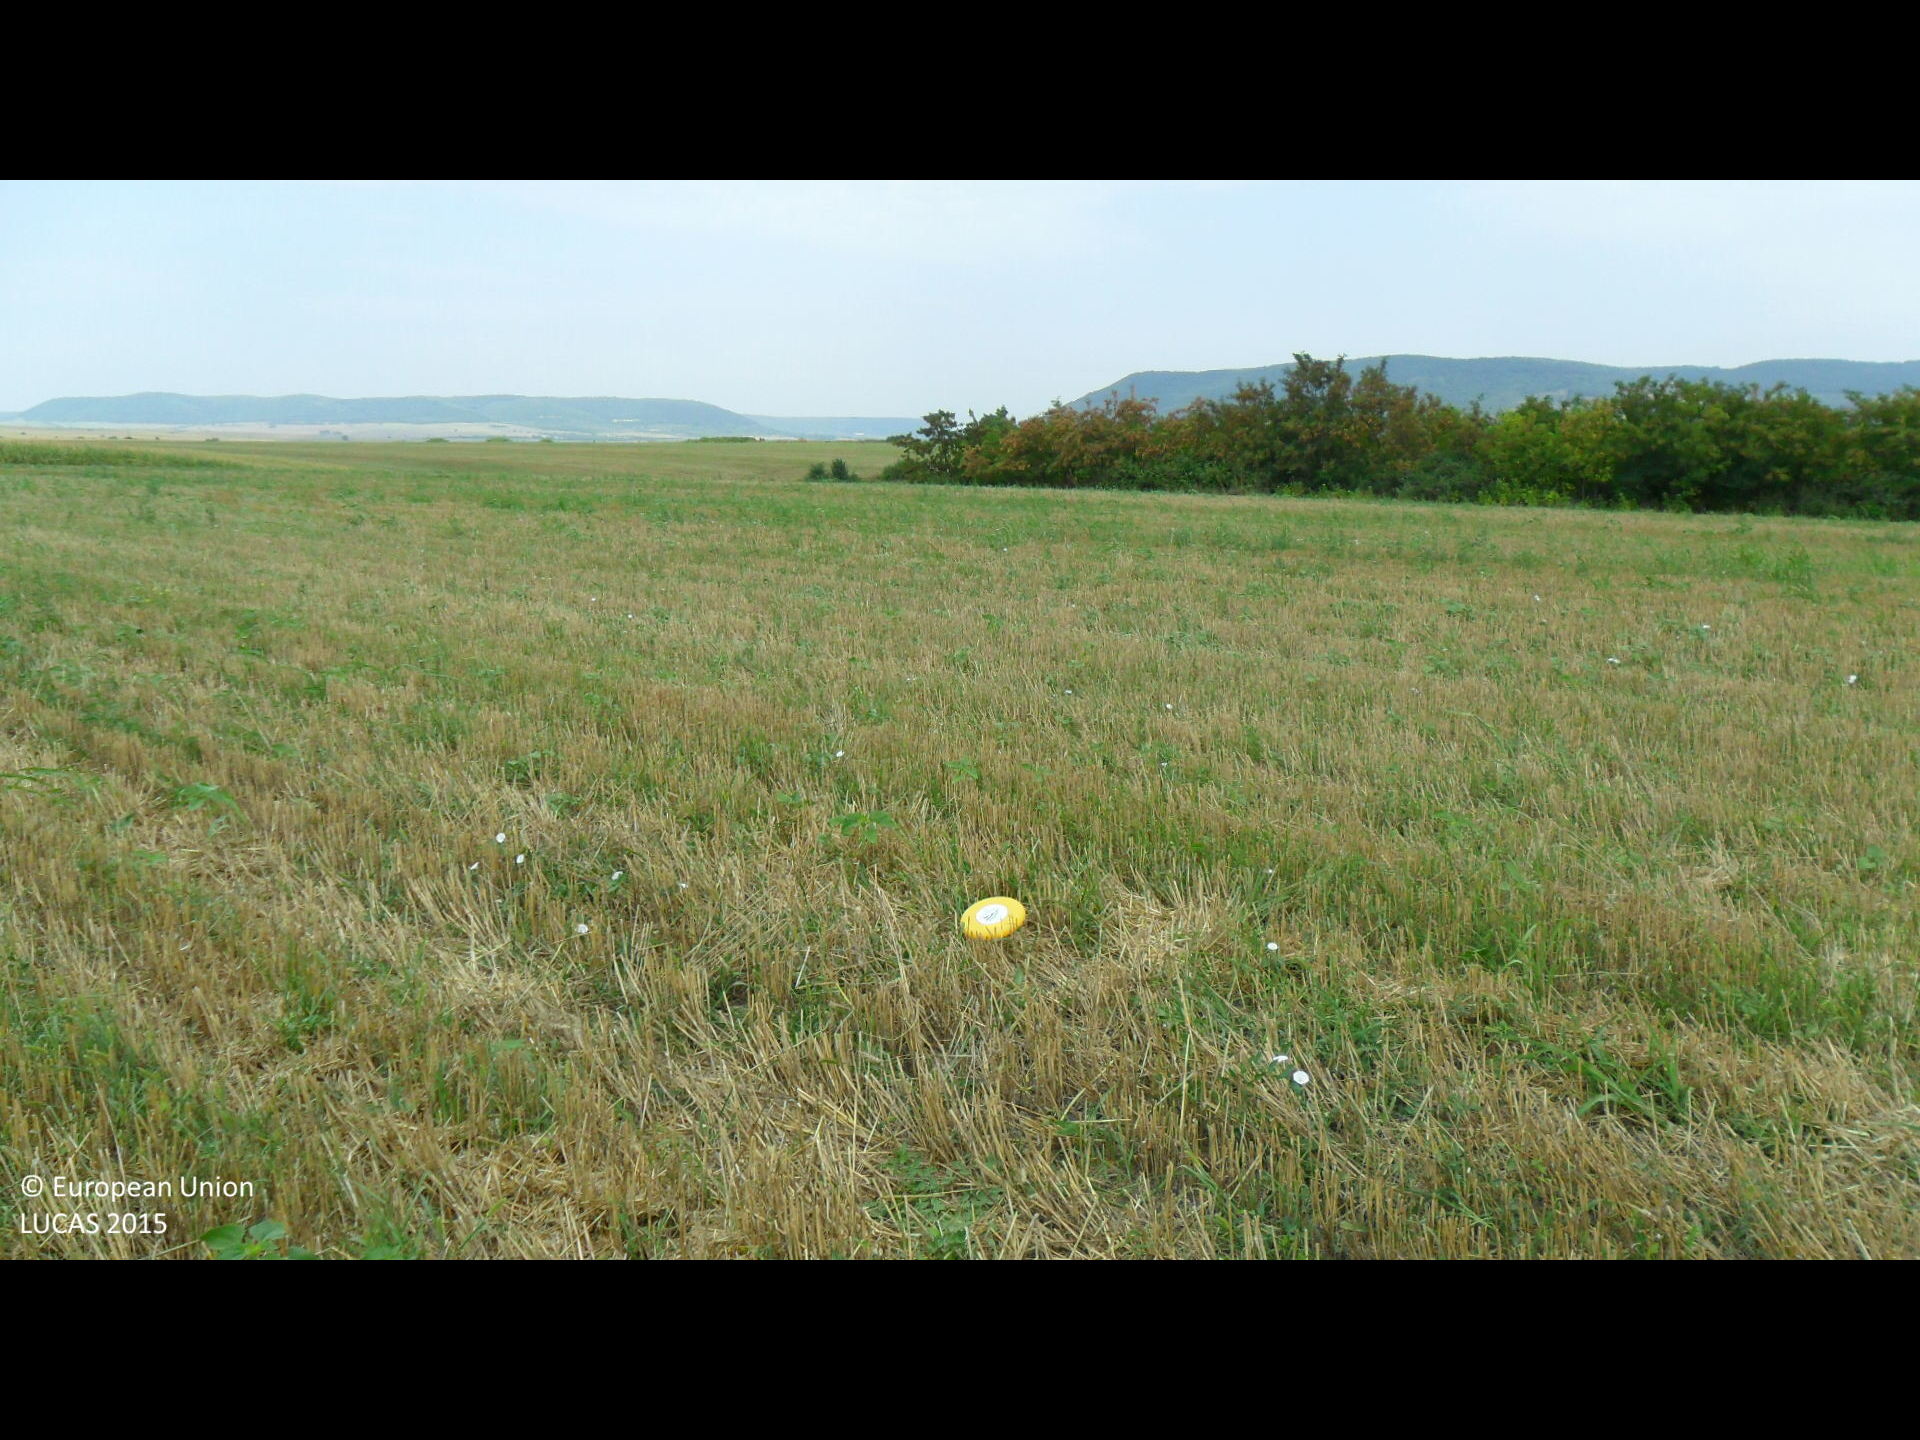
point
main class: Cropland
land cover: Barley
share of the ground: > 75 %
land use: Agriculture (excluding fallow land and kitchen gardens)
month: August
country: BG
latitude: 43.3889
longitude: 26.2569
